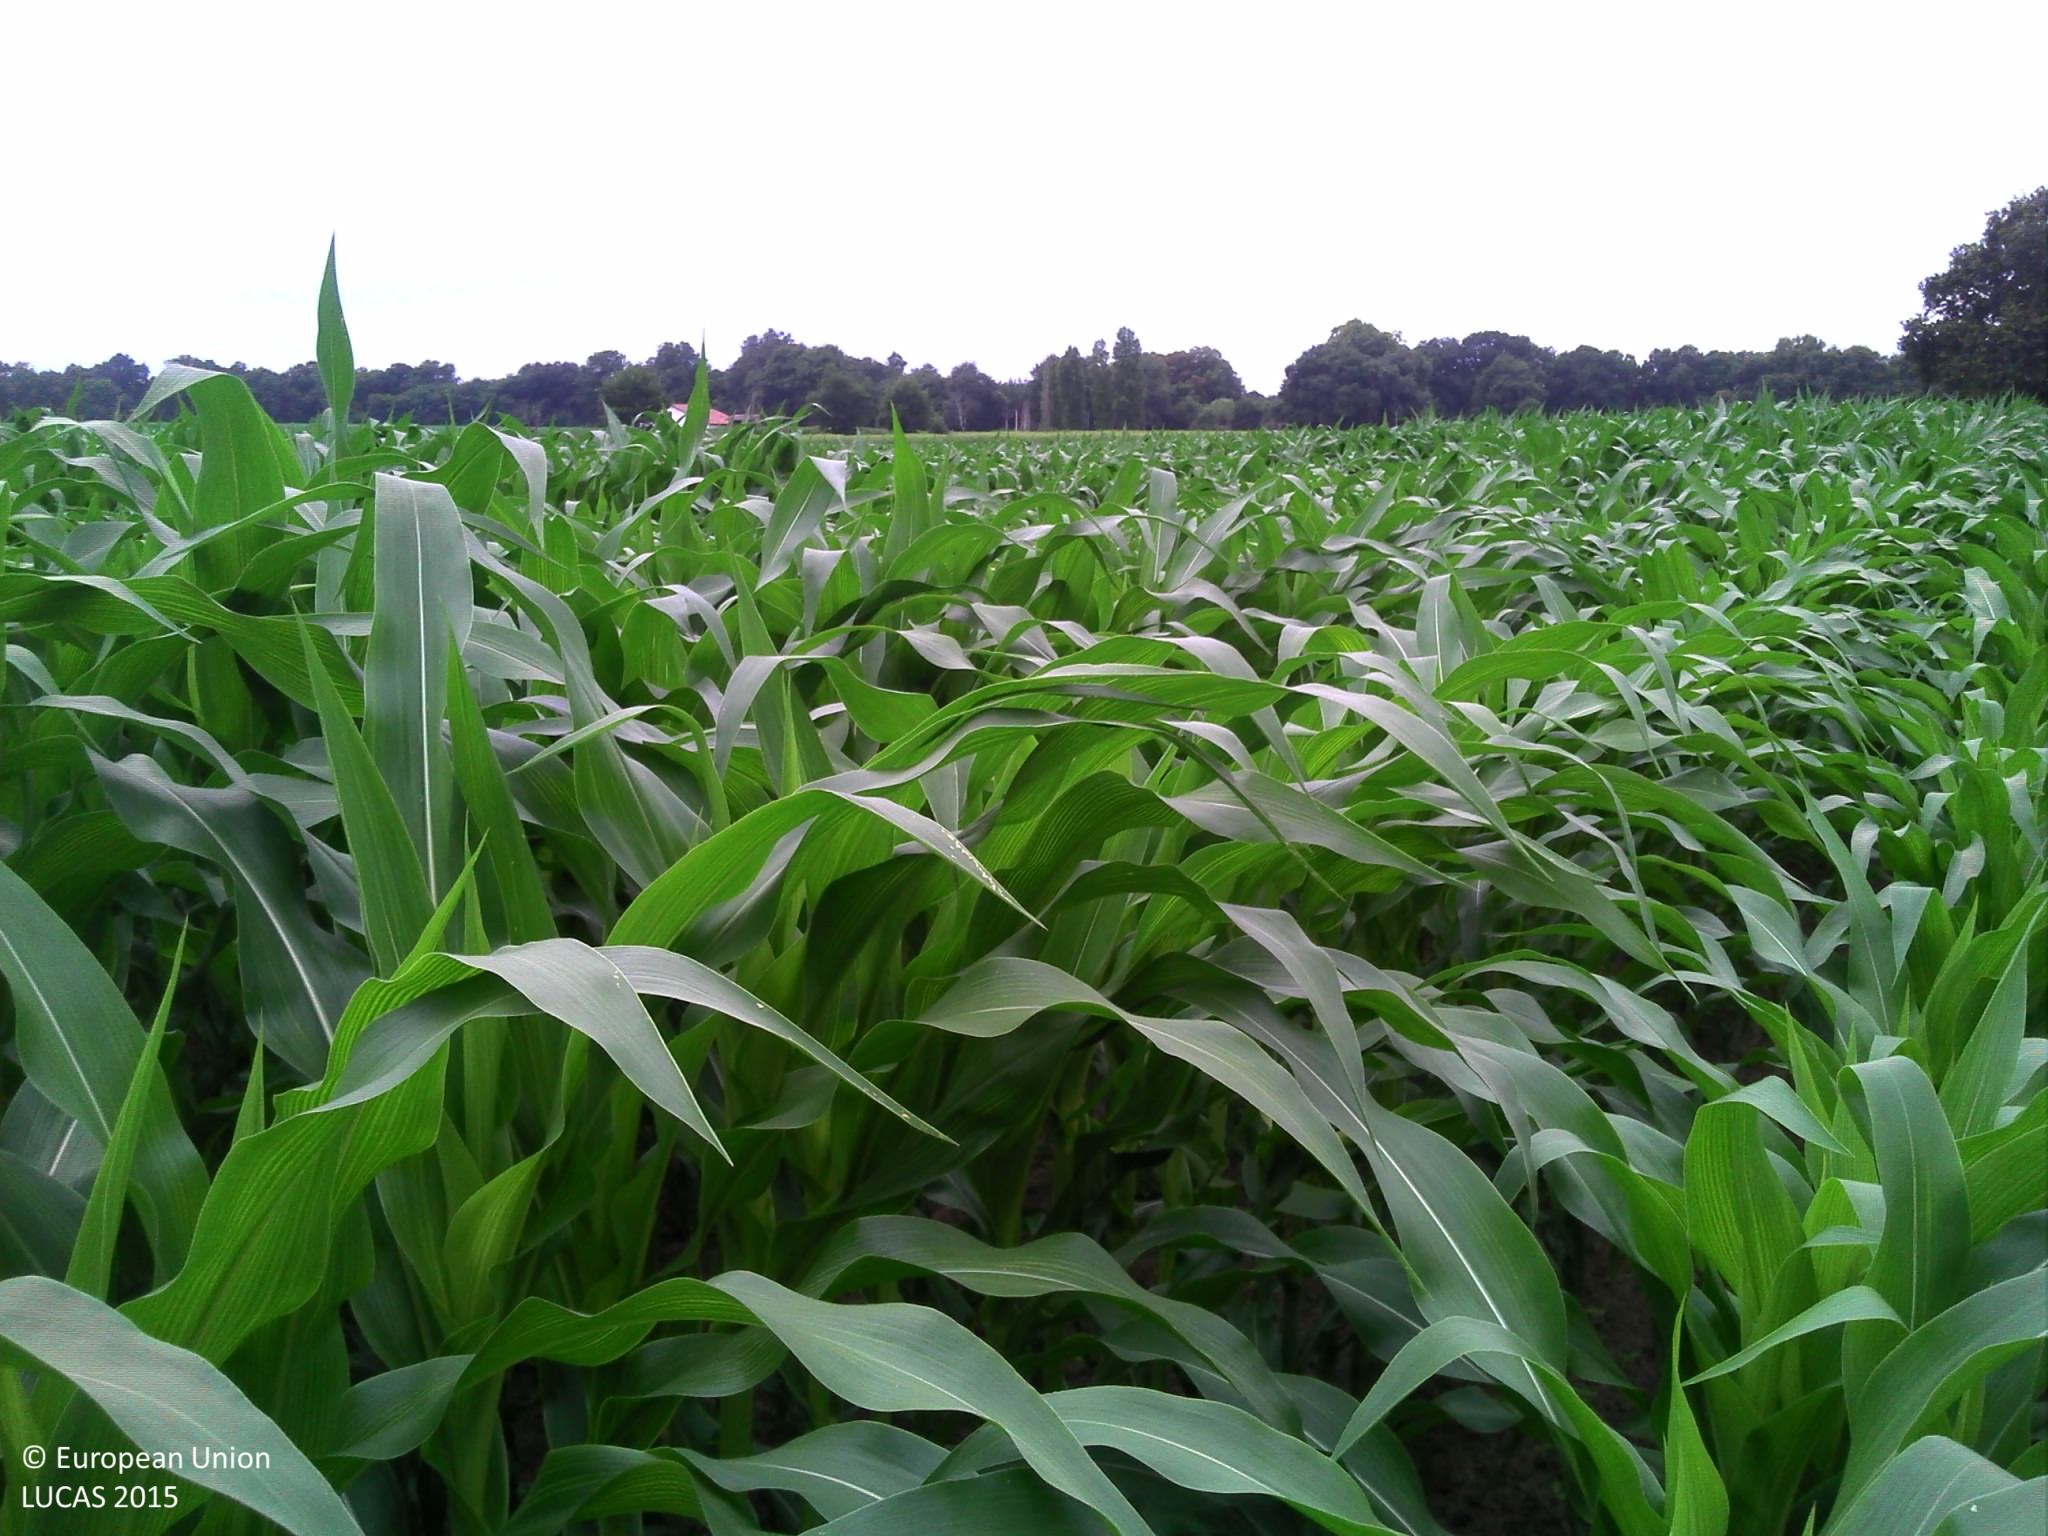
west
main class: Cropland
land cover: Maize
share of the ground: > 75 %
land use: Agriculture (excluding fallow land and kitchen gardens)
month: July
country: FR
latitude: 43.5878
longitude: -0.7752
